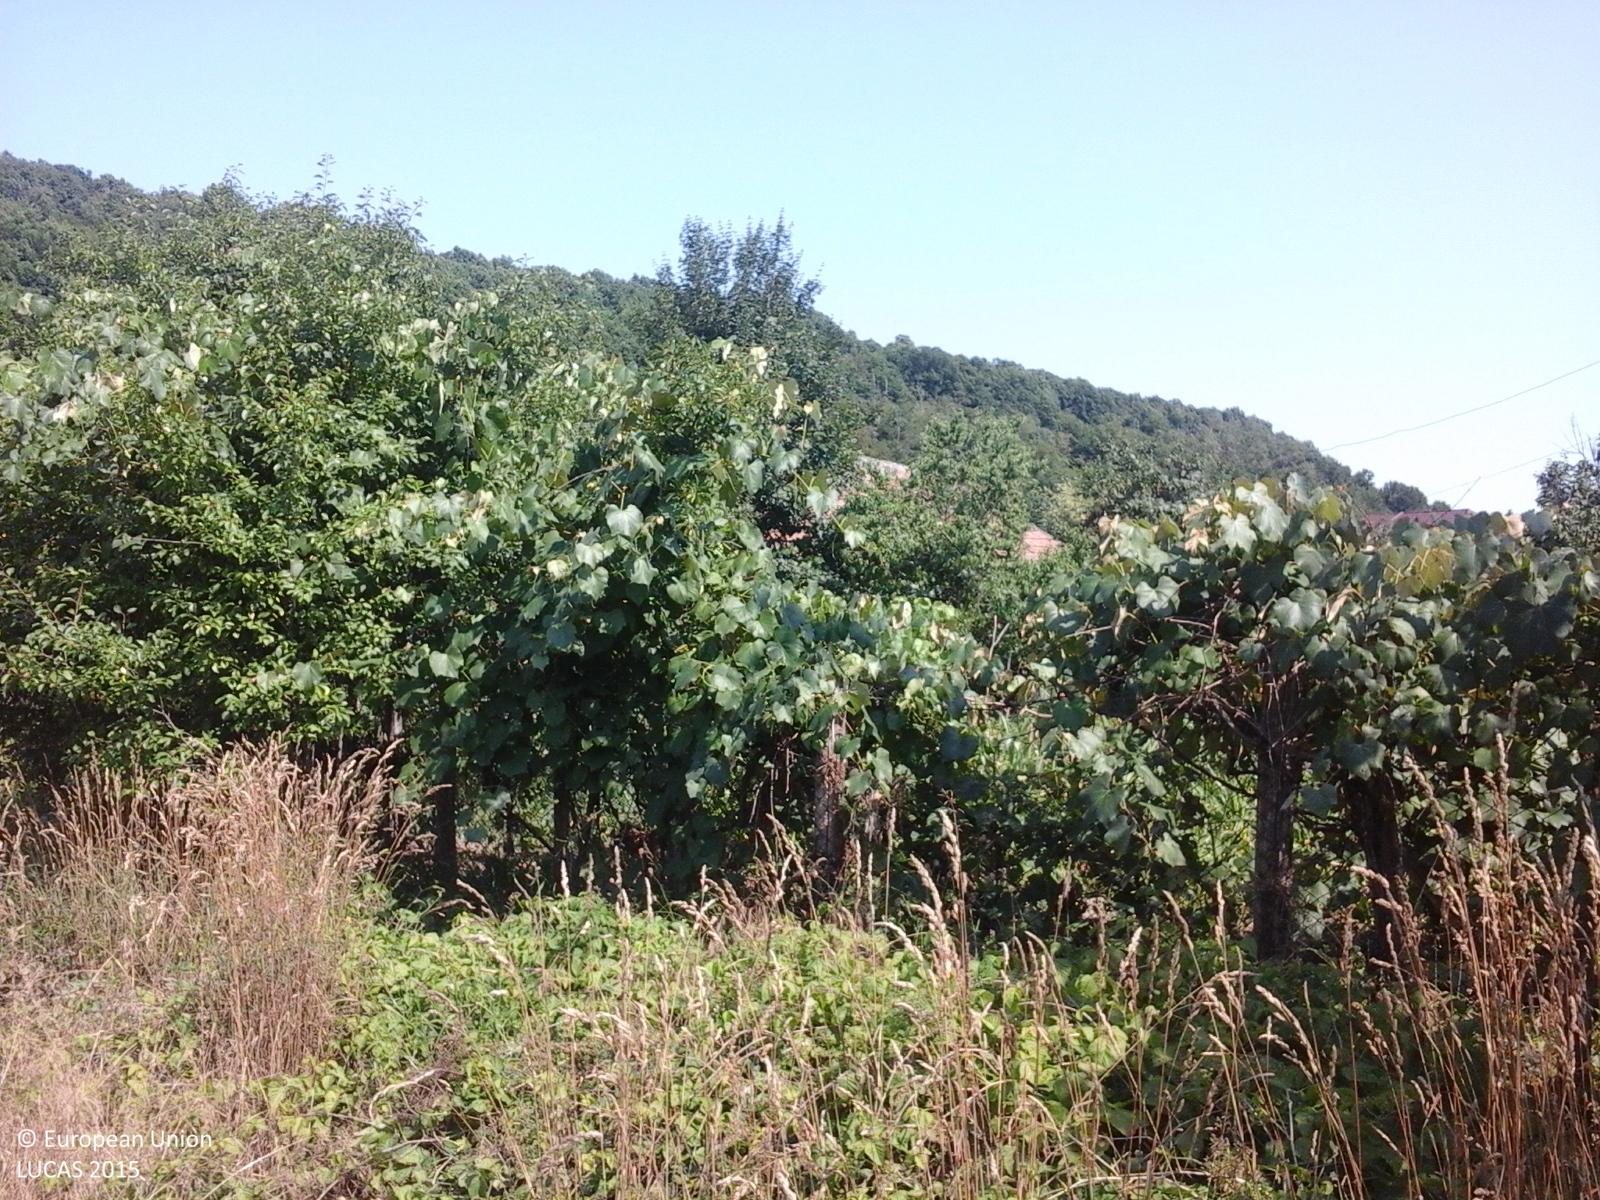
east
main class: Grassland
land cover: Spontaneously vegetated surfaces
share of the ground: > 75 %
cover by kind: herbaceous plants 100 %
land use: Agriculture (excluding fallow land and kitchen gardens)
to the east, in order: Spontaneously vegetated surfaces; Lines of trees; Grassland without tree/shrub cover; Lines of trees; Tracks; Shrubland with sparse tree cover; Inland fresh running water; Grass margins; Broadleaved woodland
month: July
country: RO
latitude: 45.0301
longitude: 24.4813
